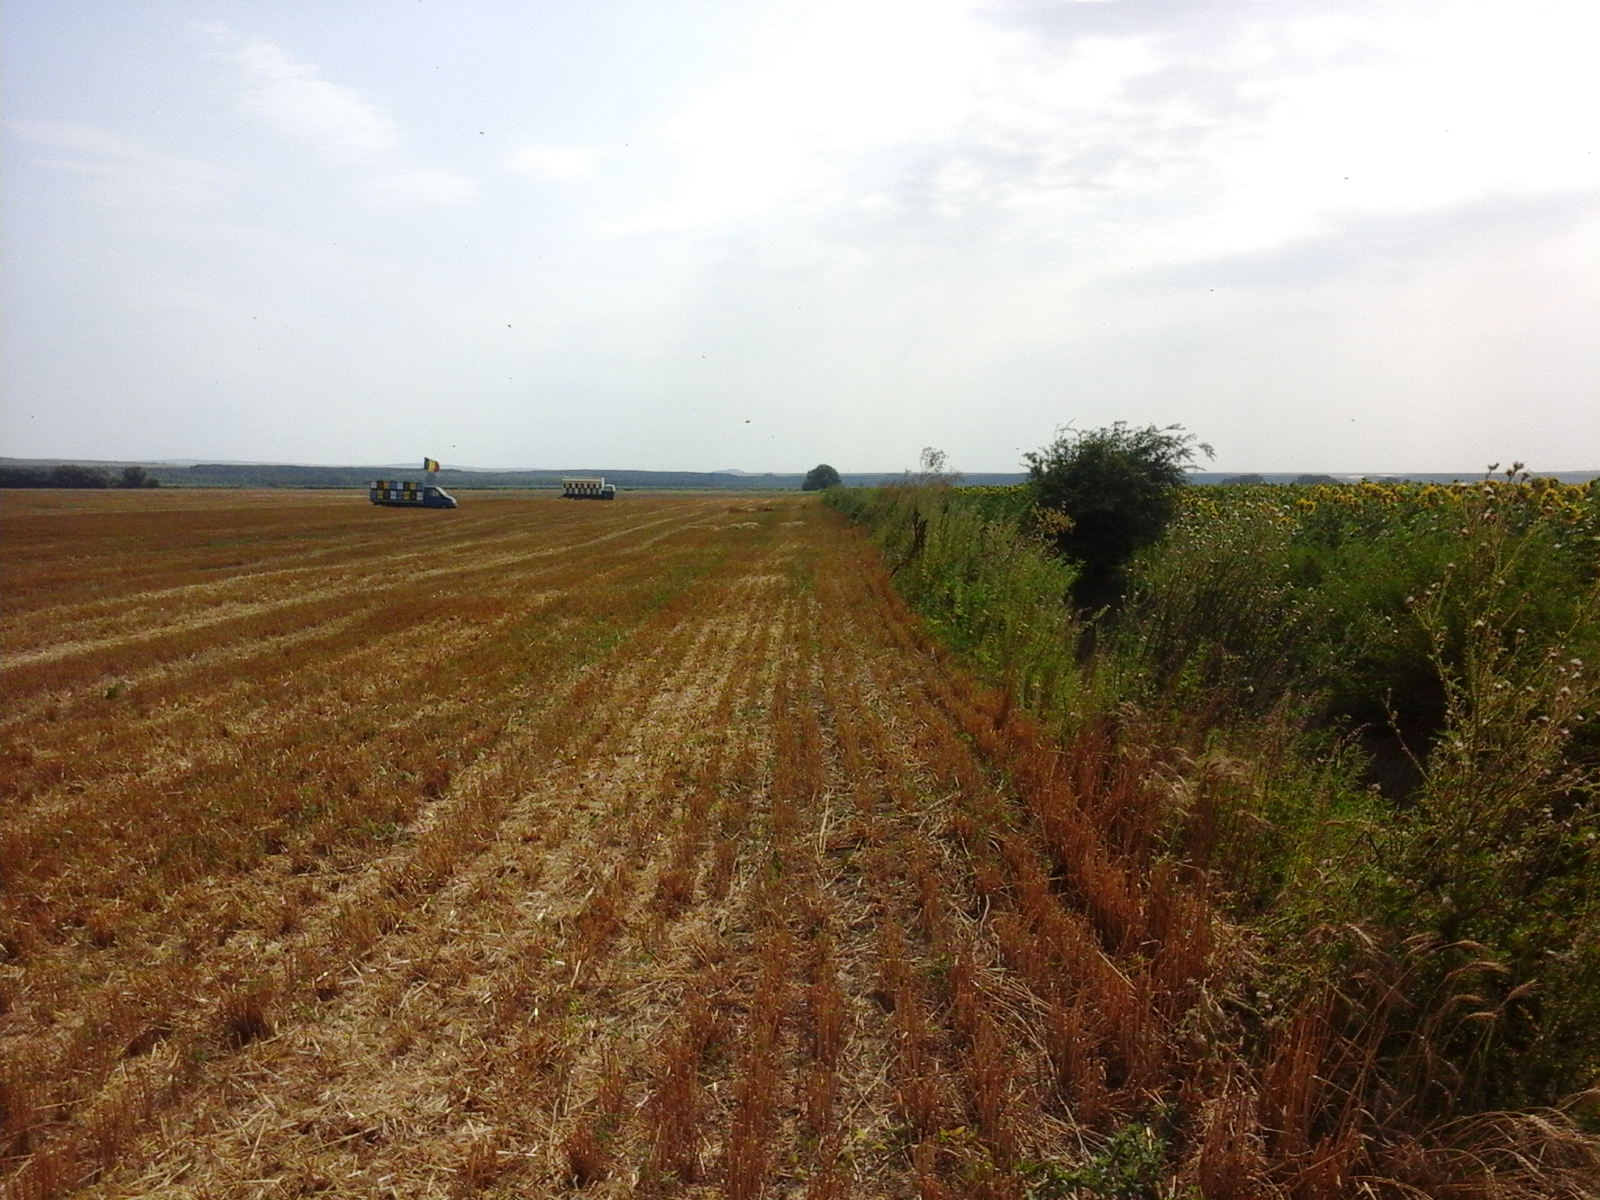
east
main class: Cropland
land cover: Sunflower
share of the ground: > 75 %
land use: Agriculture (excluding fallow land and kitchen gardens)
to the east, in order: Sunflower; Grass margins; Tracks; Grass margins; Sunflower
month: July
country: RO
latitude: 44.4895
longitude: 28.0273
